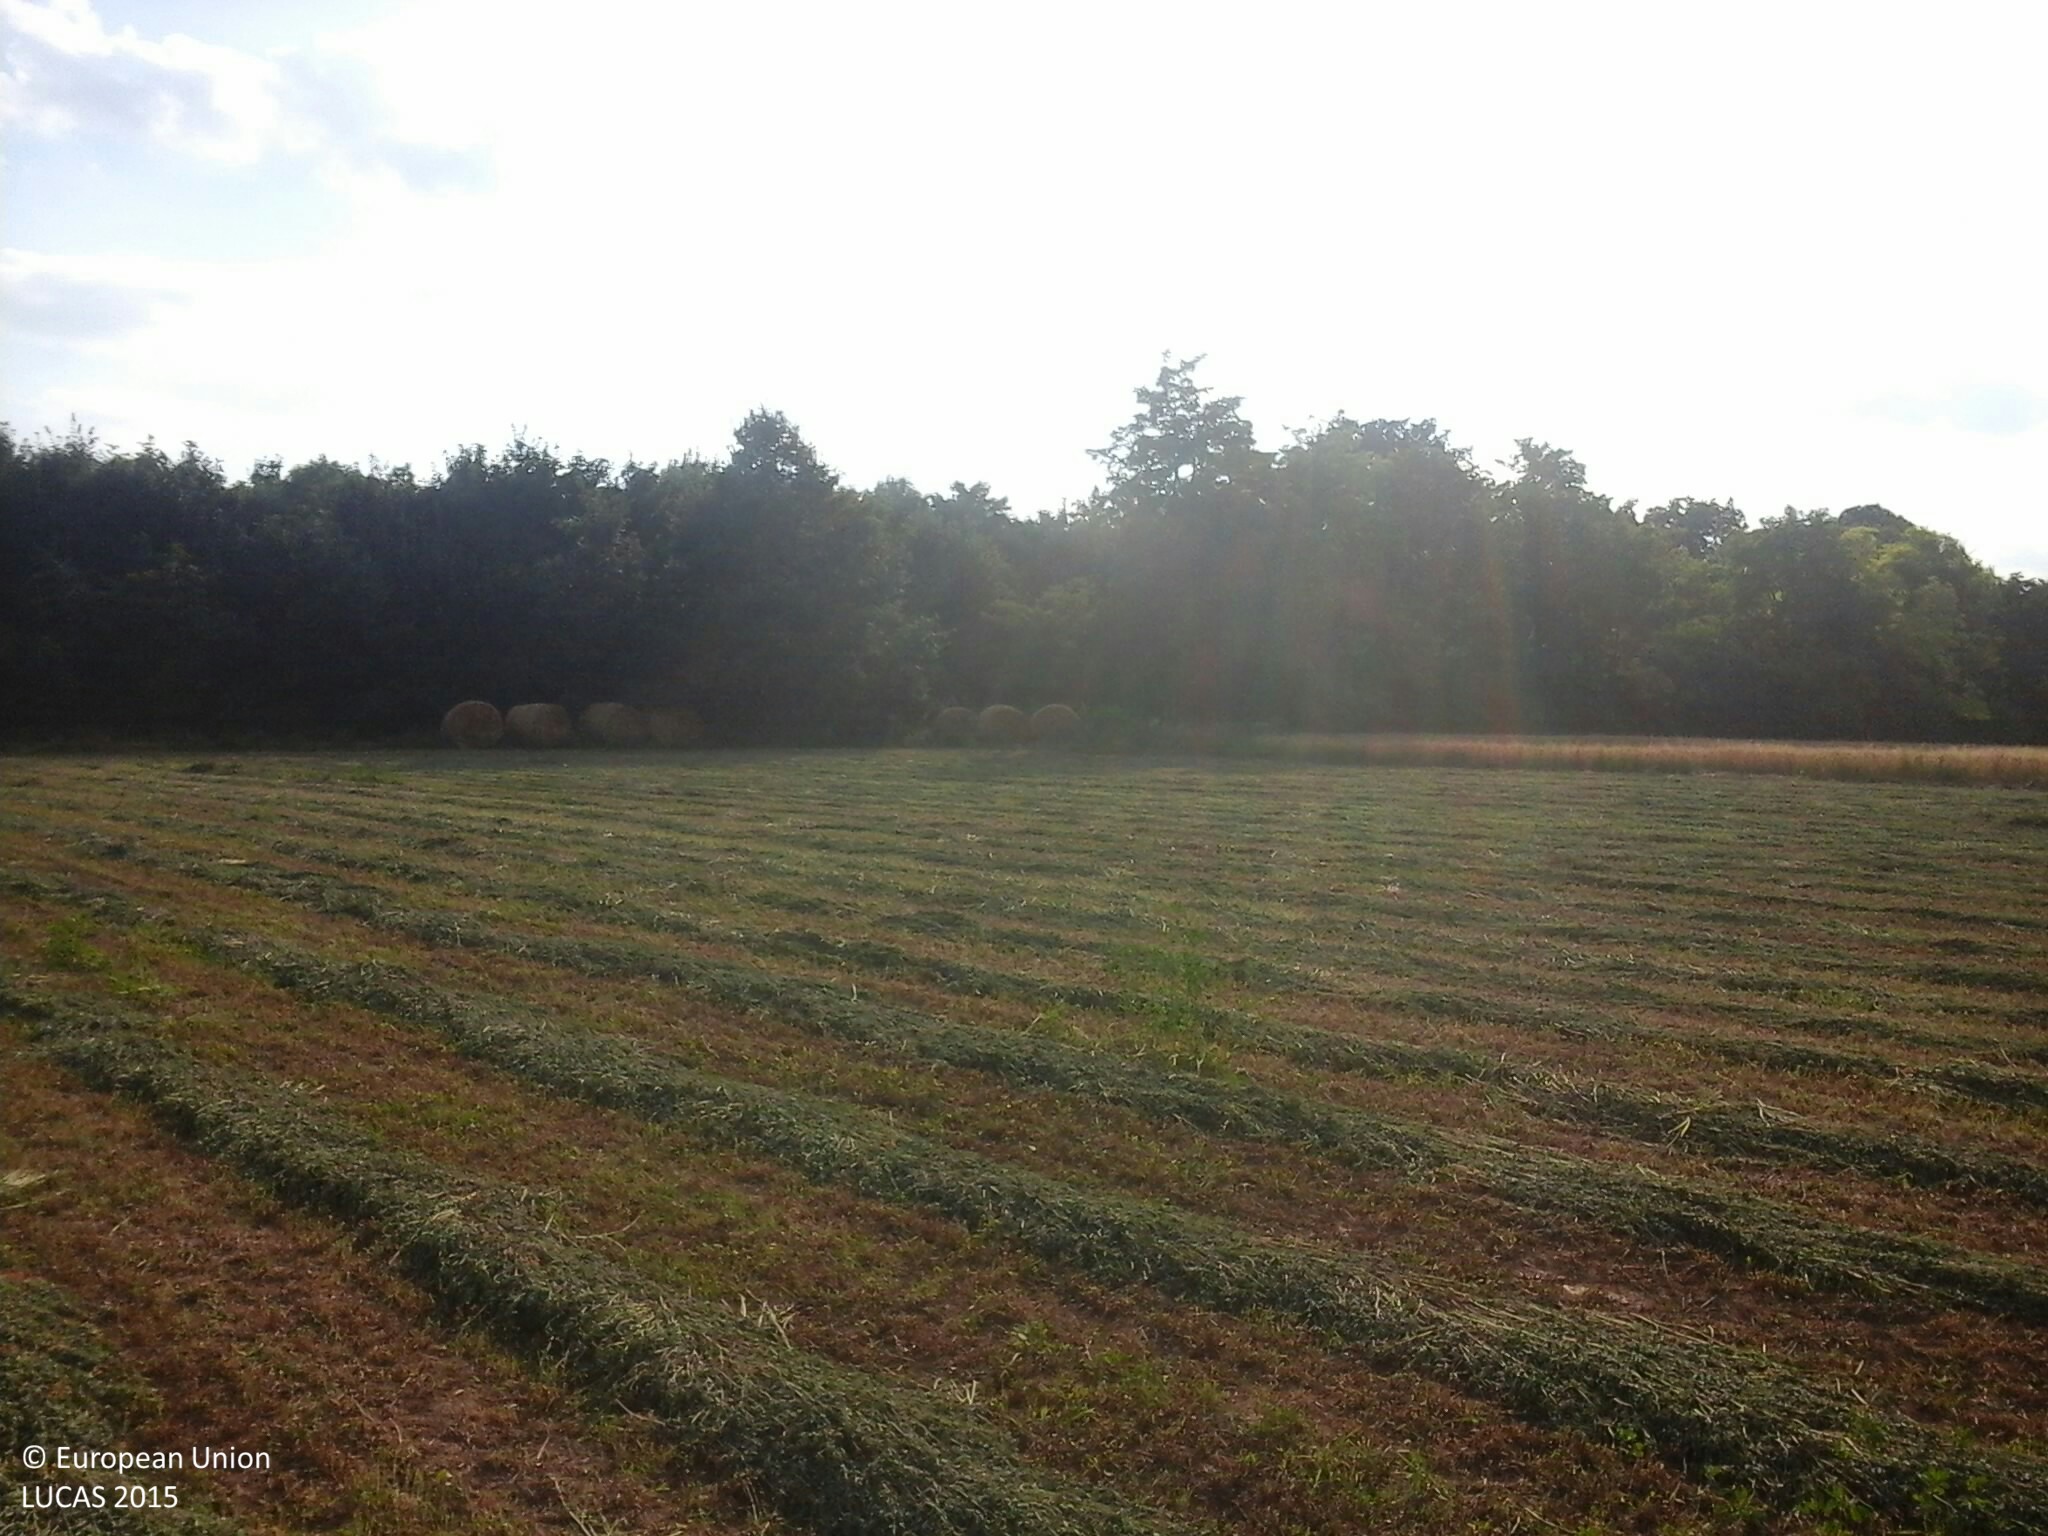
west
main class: Cropland
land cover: Lucerne
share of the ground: 25 - 50 %
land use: Agriculture (excluding fallow land and kitchen gardens)
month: July
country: HU
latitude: 47.0720
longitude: 17.8969
